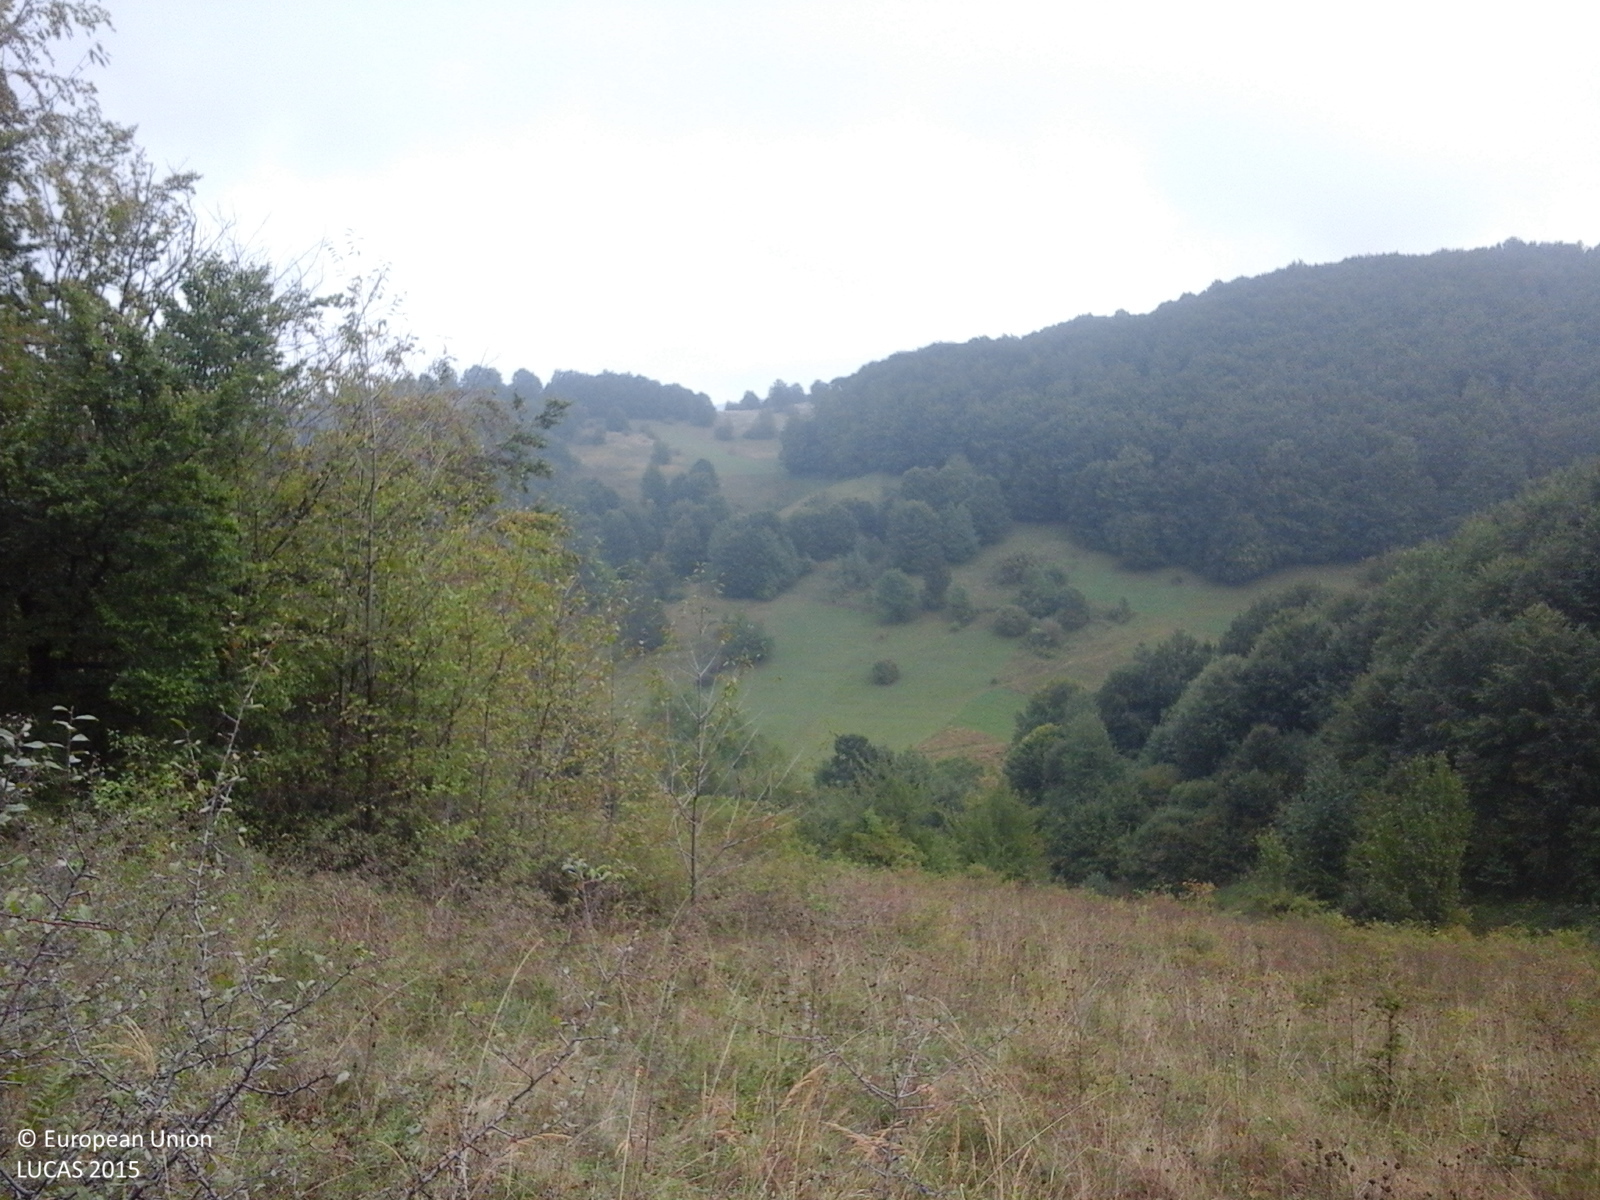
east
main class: Shrubland
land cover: Shrubland with sparse tree cover
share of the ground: > 75 %
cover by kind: shrubs 95 %, broadleaved forest trees 5 %
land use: Fallow land
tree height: < 5 m
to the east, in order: Shrubland with sparse tree cover; Grassland with sparse tree/shrub cover; Single bushes/trees; Grassland with sparse tree/shrub cover; Broadleaved woodland; Grassland without tree/shrub cover
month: September
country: RO
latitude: 46.8826
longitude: 22.5603
